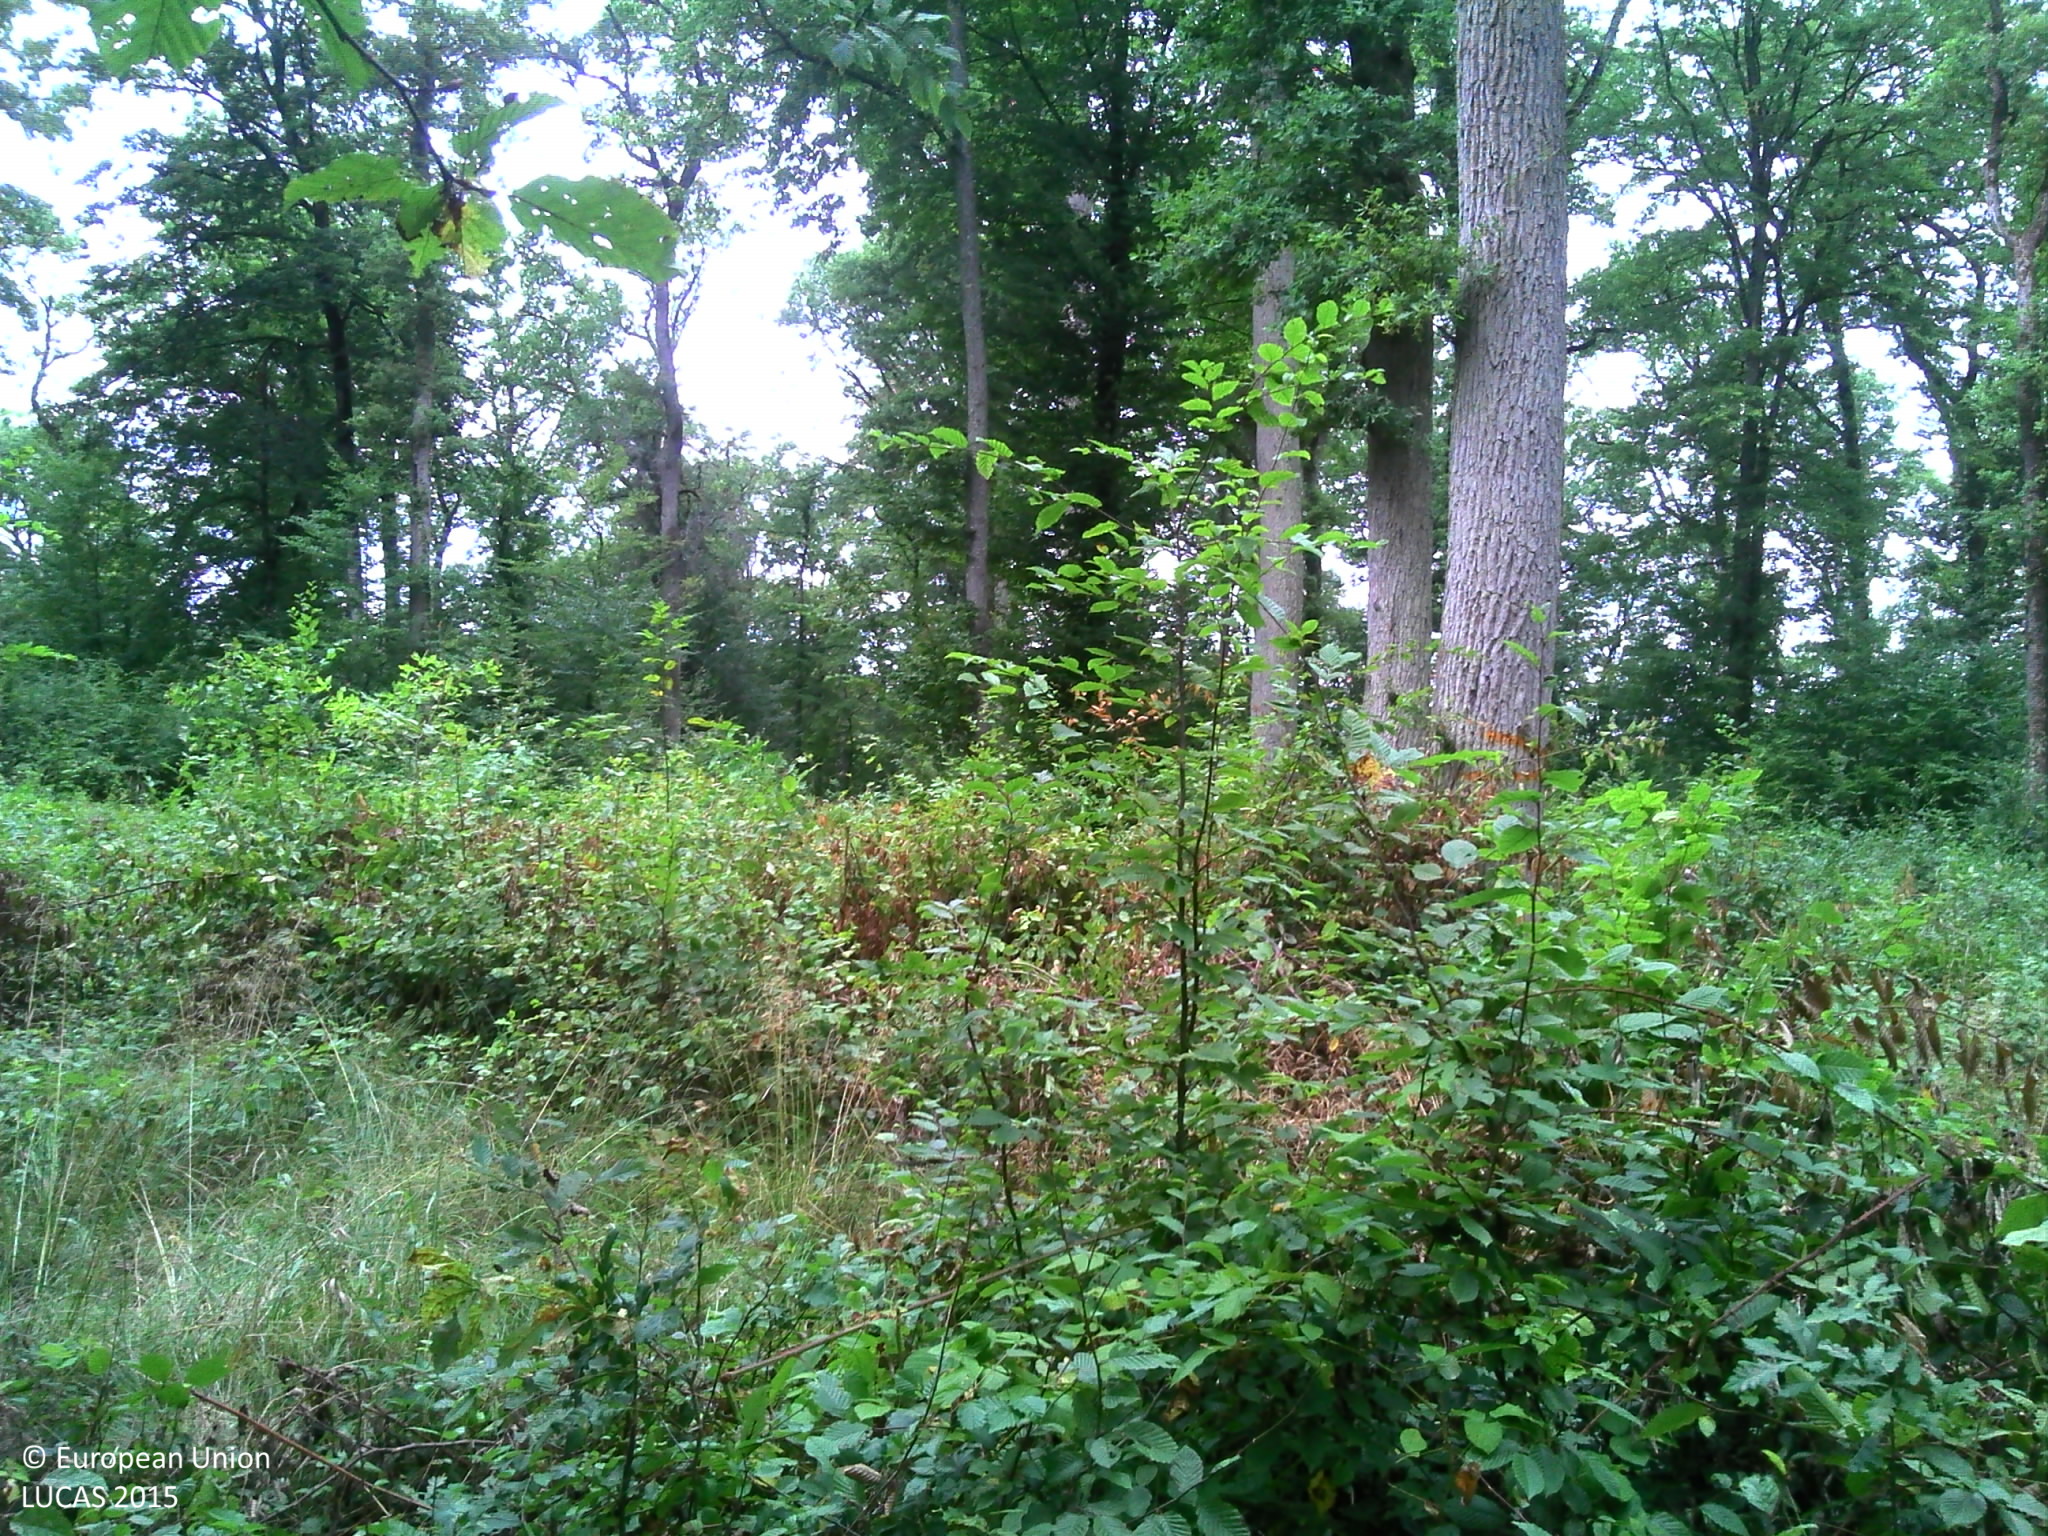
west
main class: Woodland
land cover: Broadleaved woodland
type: mesophytic deciduous forest
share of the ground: > 75 %
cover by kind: broadleaved forest trees 80 %, herbaceous plants 20 %
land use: Forestry
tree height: > 5 m
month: August
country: FR
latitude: 48.8835
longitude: 7.6960
